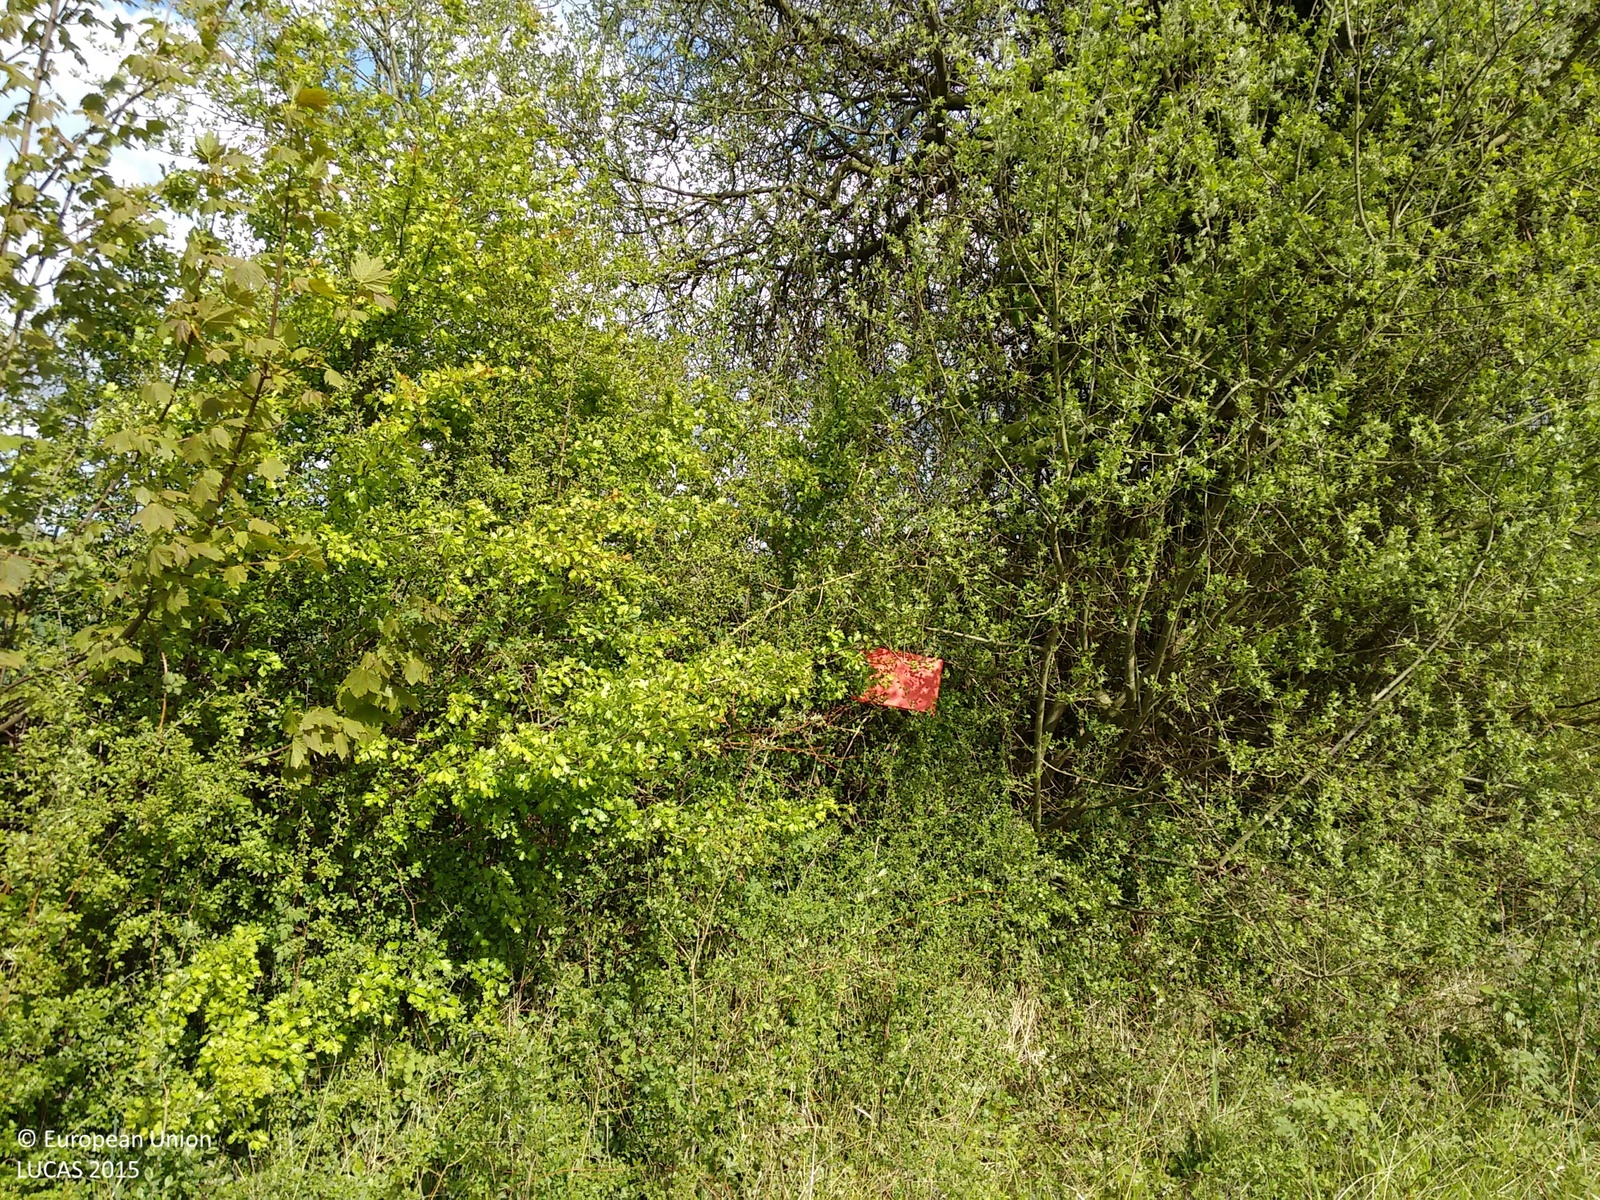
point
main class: Woodland
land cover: Broadleaved woodland
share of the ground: > 75 %
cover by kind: broadleaved forest trees 50 %, herbaceous plants 50 %
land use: Semi-natural and natural areas not in use
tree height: < 5 m
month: May
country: GB
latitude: 51.9062
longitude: -0.5480
